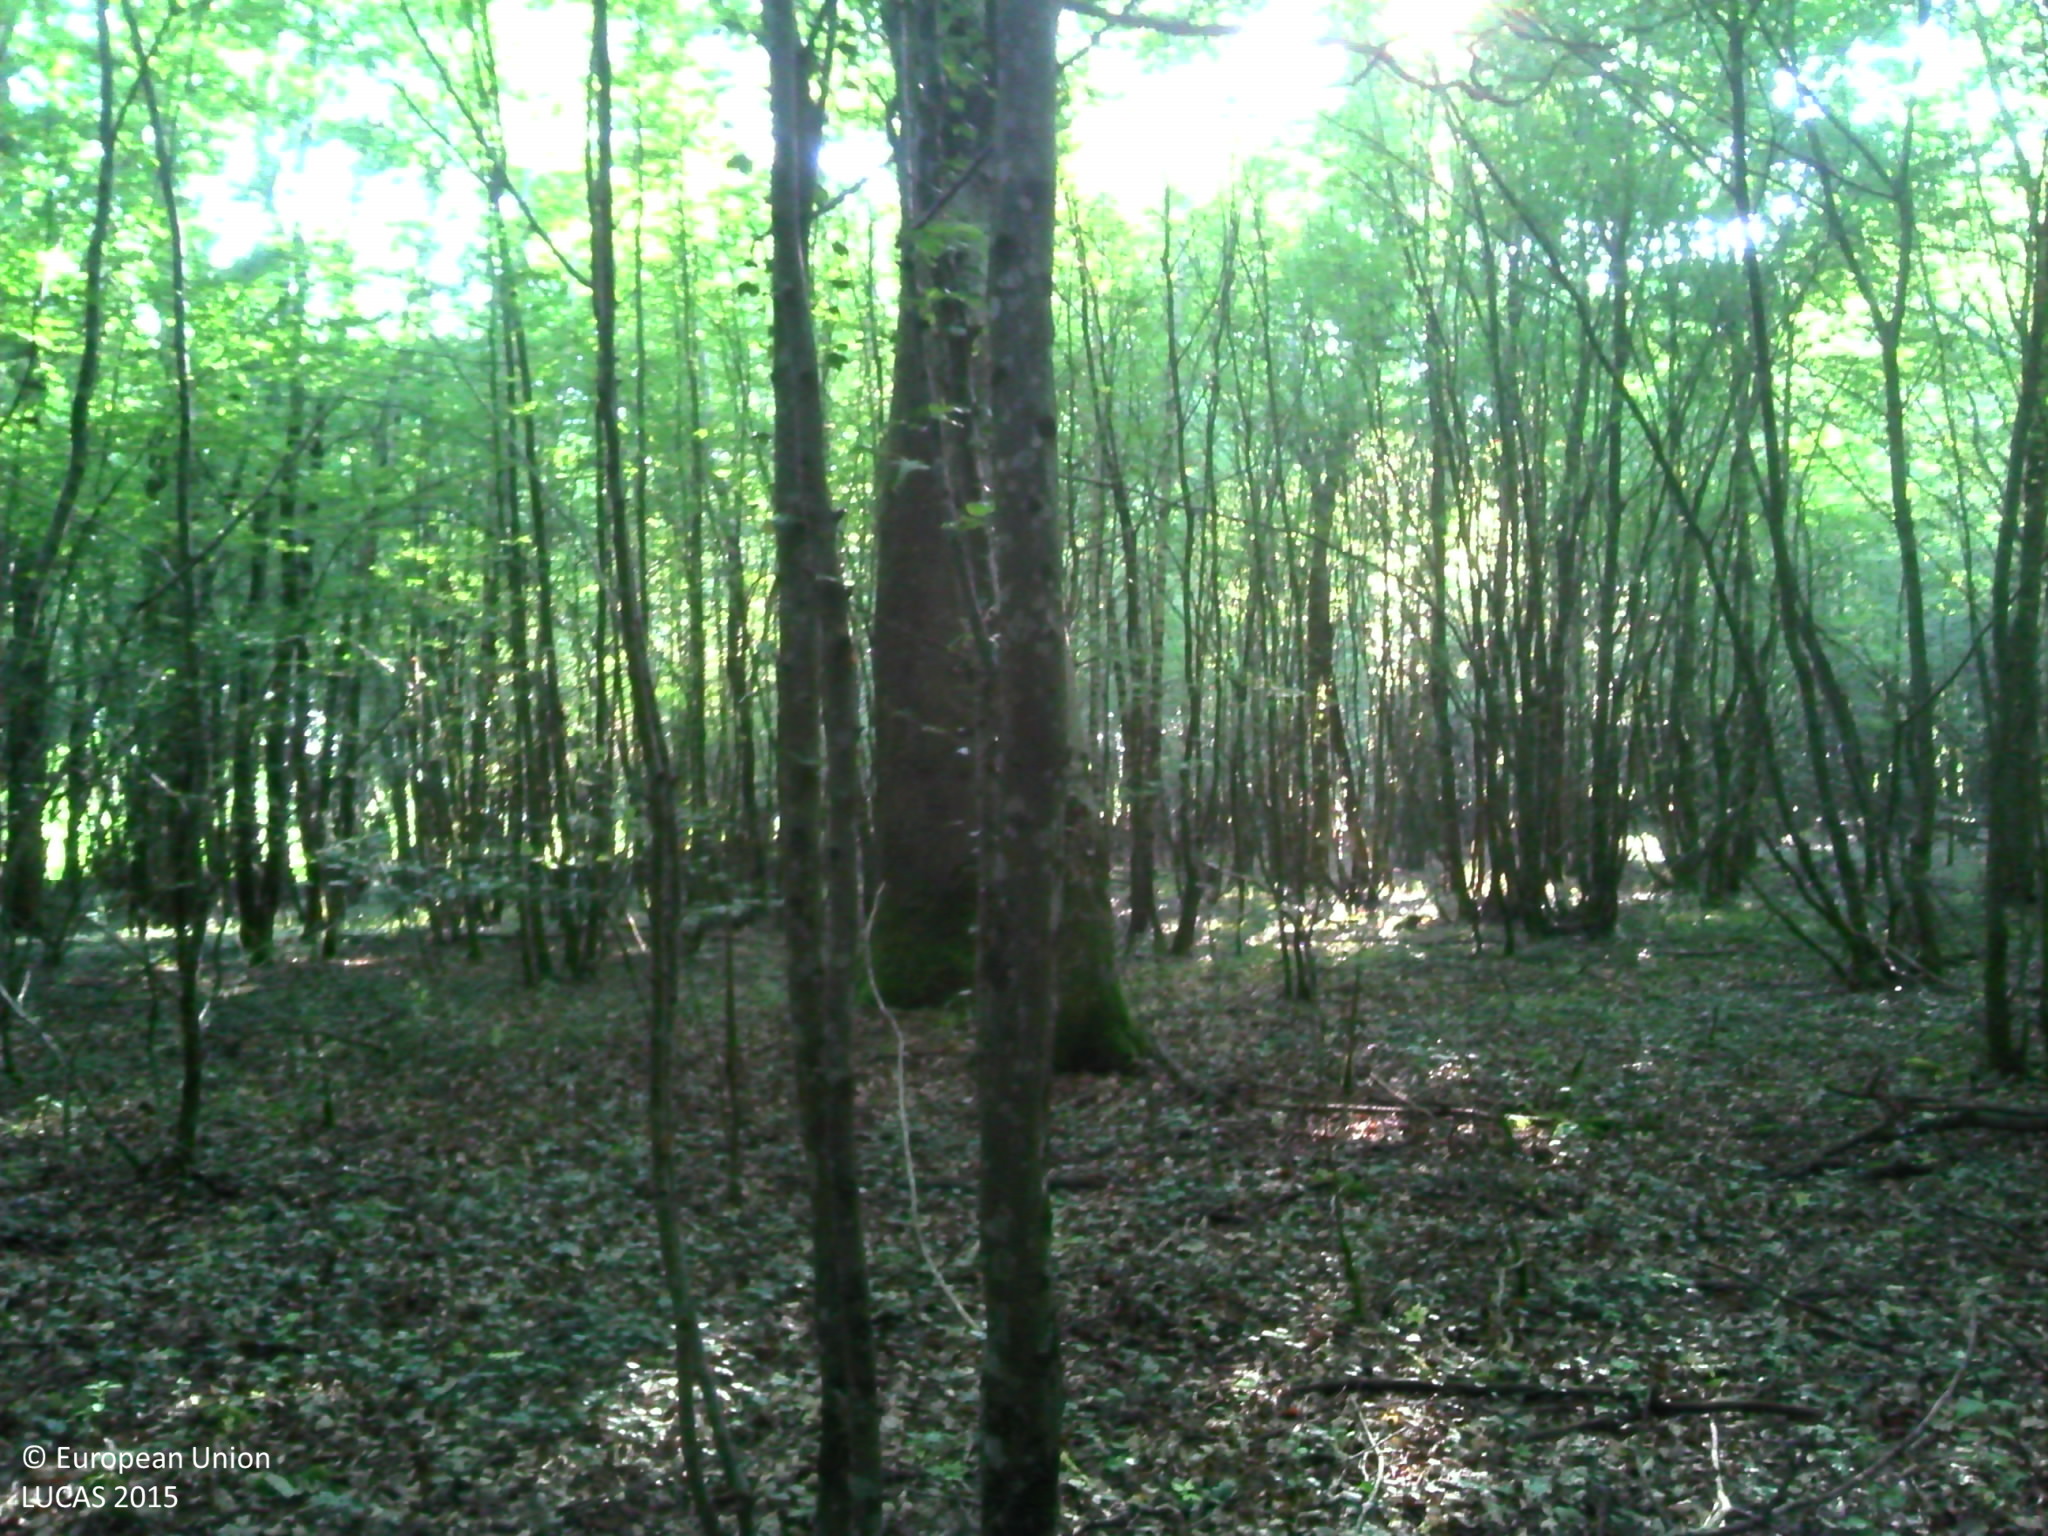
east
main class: Woodland
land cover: Broadleaved woodland
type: acidophilous oak and oak-birch forest
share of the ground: > 75 %
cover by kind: broadleaved forest trees 95 %, herbaceous plants 5 %
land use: Forestry
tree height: > 5 m
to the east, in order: Broadleaved woodland; Tracks; Broadleaved woodland; Fences; Grassland without tree/shrub cover
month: June
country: FR
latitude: 46.7026
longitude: 5.3853
